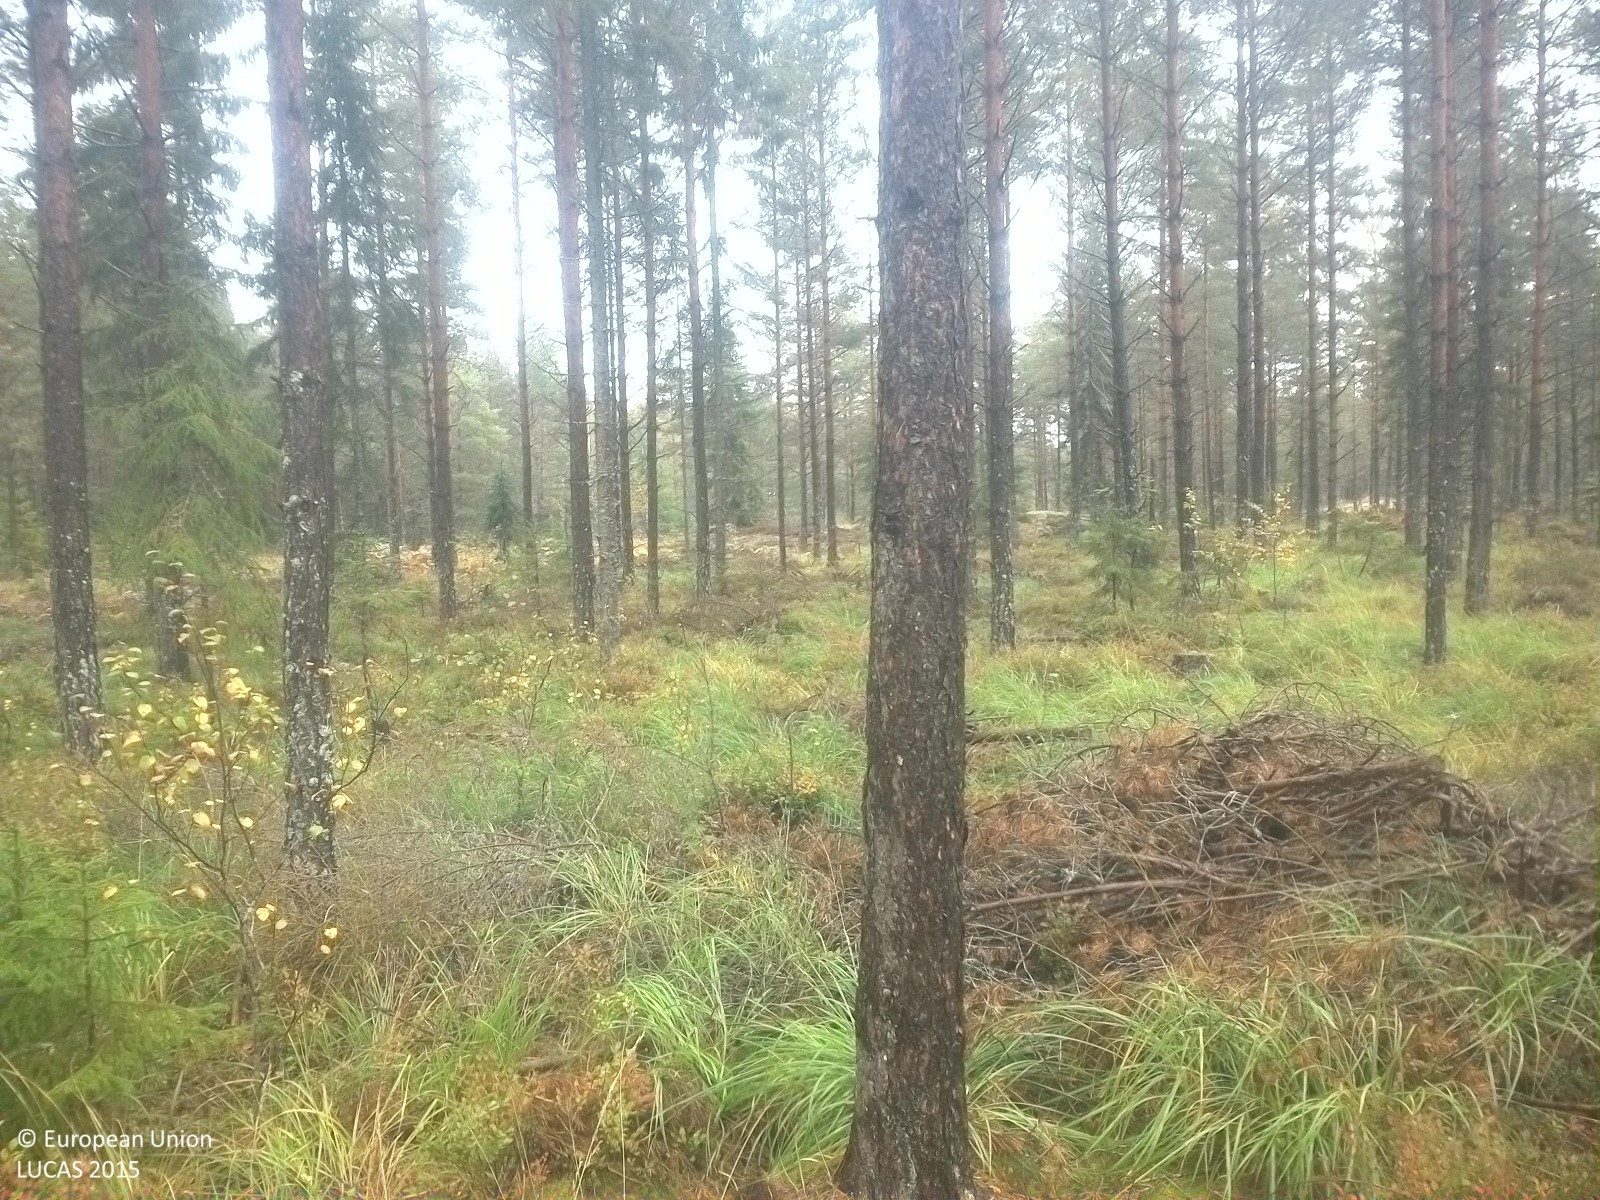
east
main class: Woodland
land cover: Pine dominated coniferous woodland
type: boreal forest
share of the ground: 25 - 50 %
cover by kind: herbaceous plants 50 %, coniferous forest trees 30 %, lichens and mosses 10 %, broadleaved forest trees 5 %, shrubs 5 %
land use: Forestry
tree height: > 5 m
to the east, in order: Pine dominated coniferous woodland; Tracks; Groves; Ditches and canals; Pine dominated coniferous woodland
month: September
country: SE
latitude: 58.8323
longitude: 16.2481
